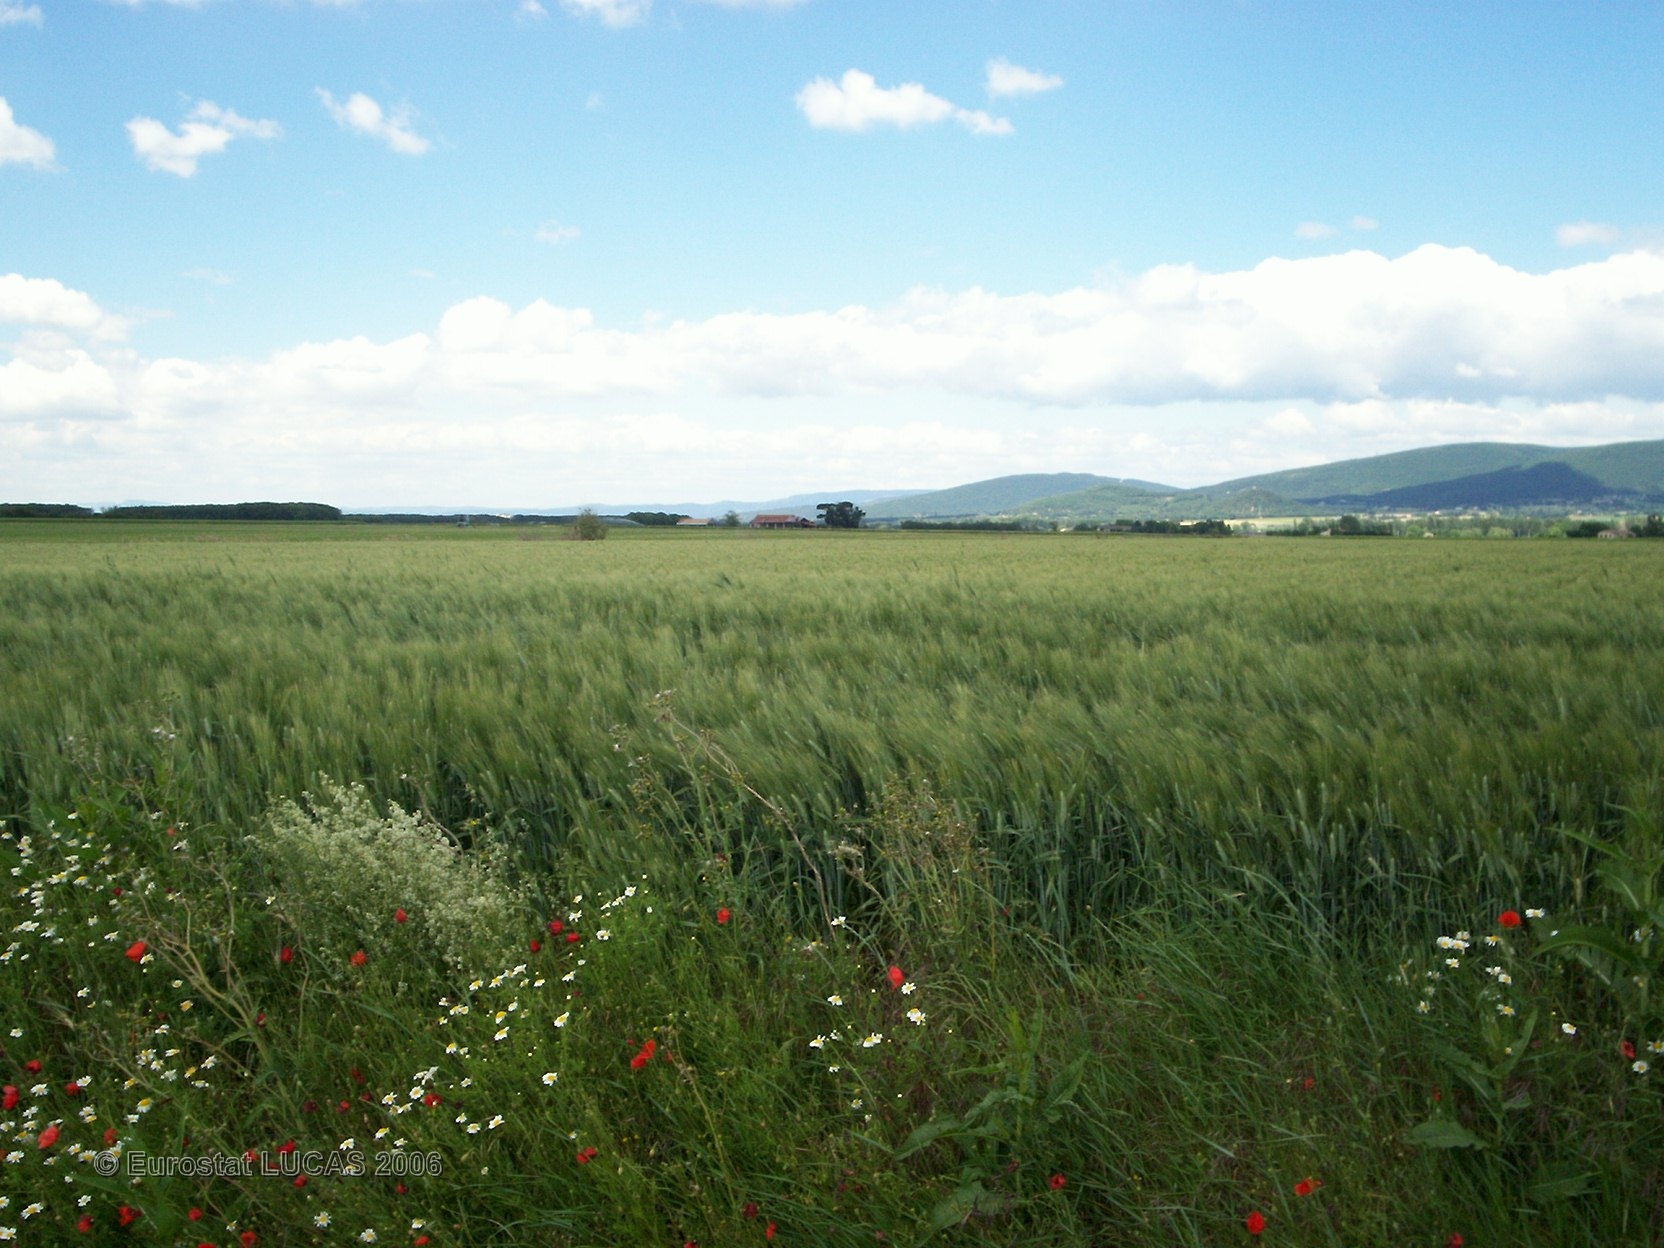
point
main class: Cropland
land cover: Durum wheat
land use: Agriculture (excluding fallow land and kitchen gardens)
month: May
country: FR
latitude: 44.6240
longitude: 4.9273
